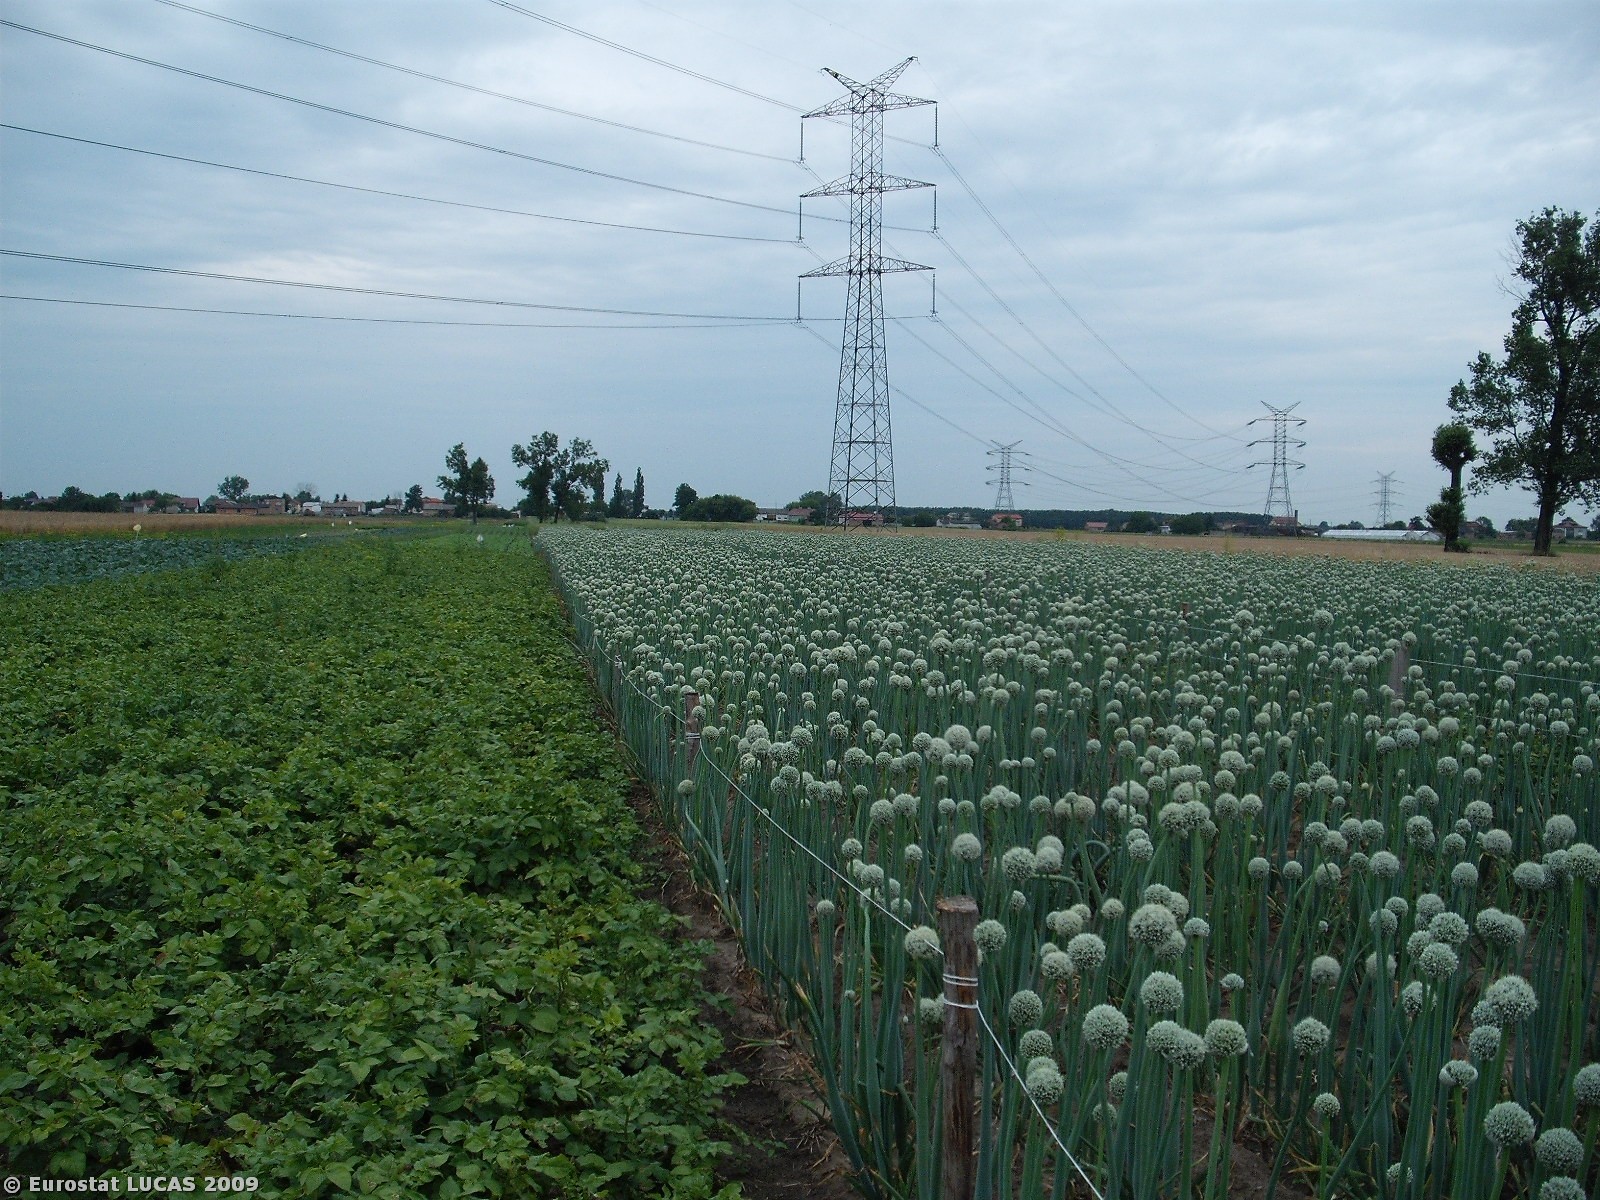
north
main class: Cropland
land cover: Potatoes
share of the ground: > 75 %
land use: Agriculture (excluding fallow land and kitchen gardens)
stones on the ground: < 10 %
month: July
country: PL
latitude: 52.2481
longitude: 20.7778
